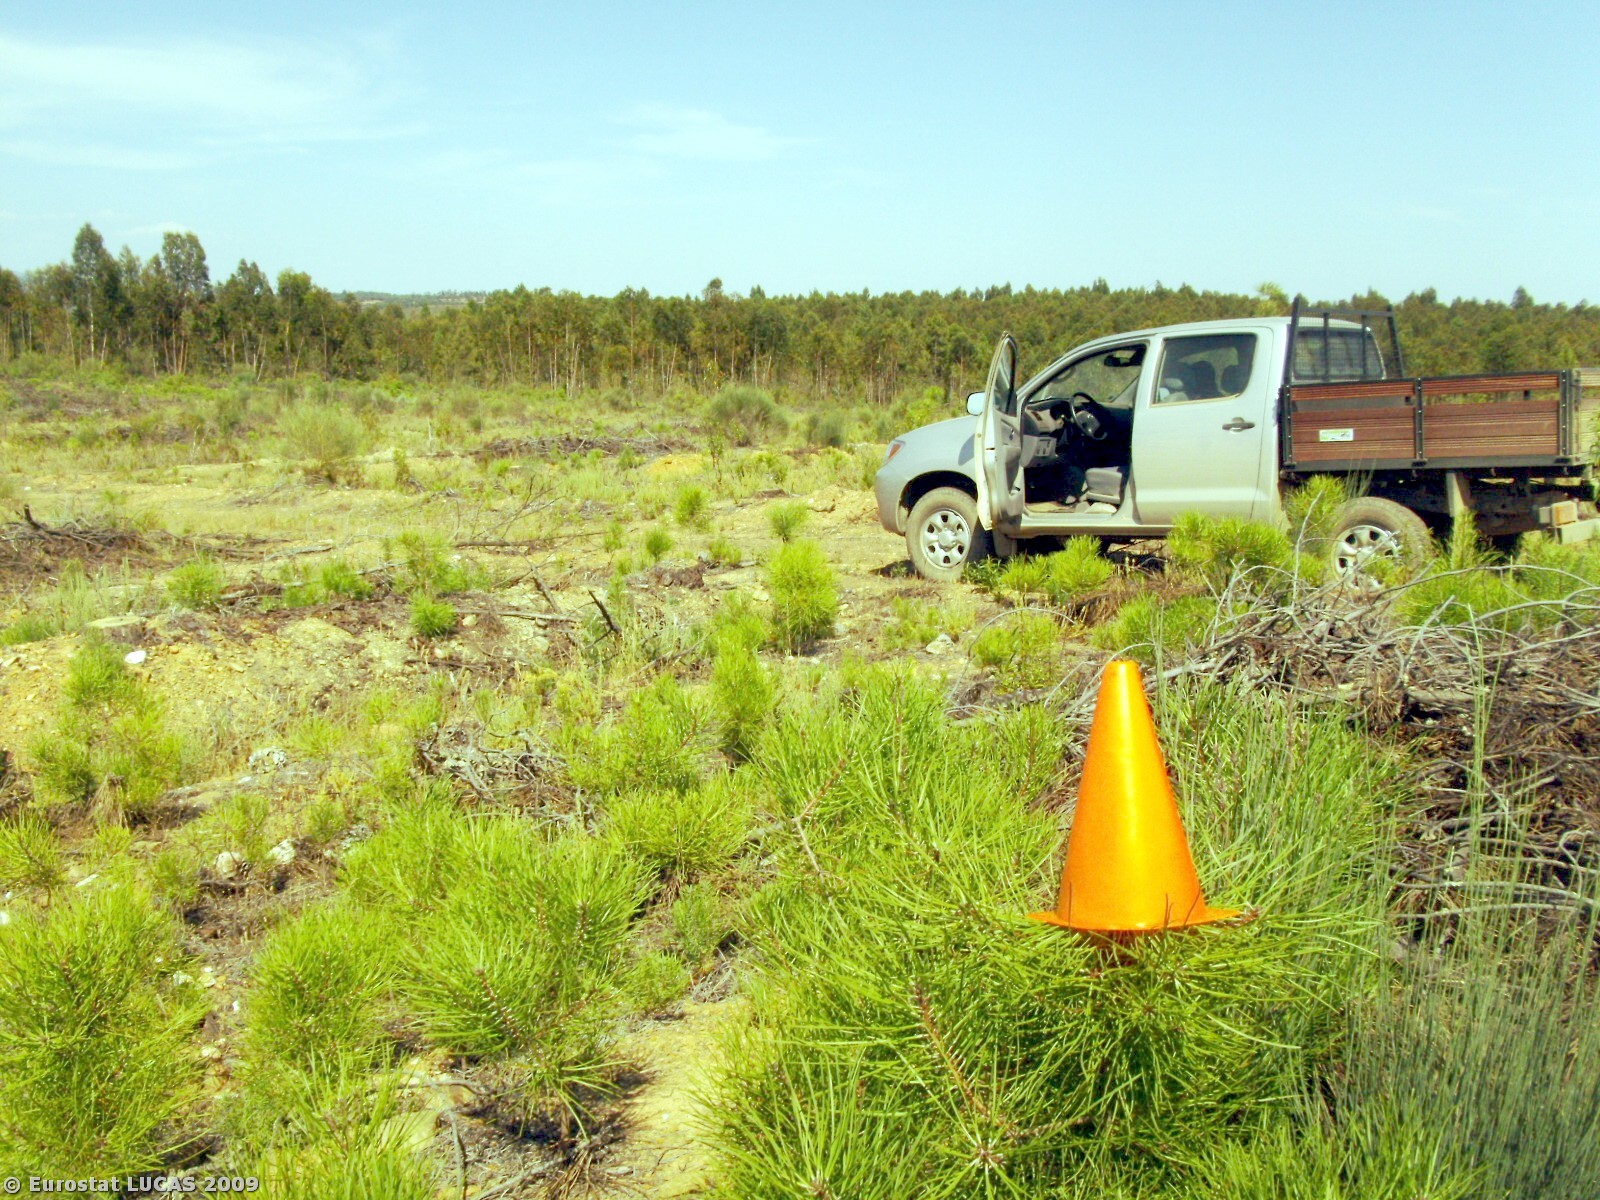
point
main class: Woodland
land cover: Coniferous woodland
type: coniferous forest of the mediterranean region
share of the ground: 25 - 50 %
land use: Forestry
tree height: > 5 m
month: July
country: PT
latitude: 40.0414
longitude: -6.9078
